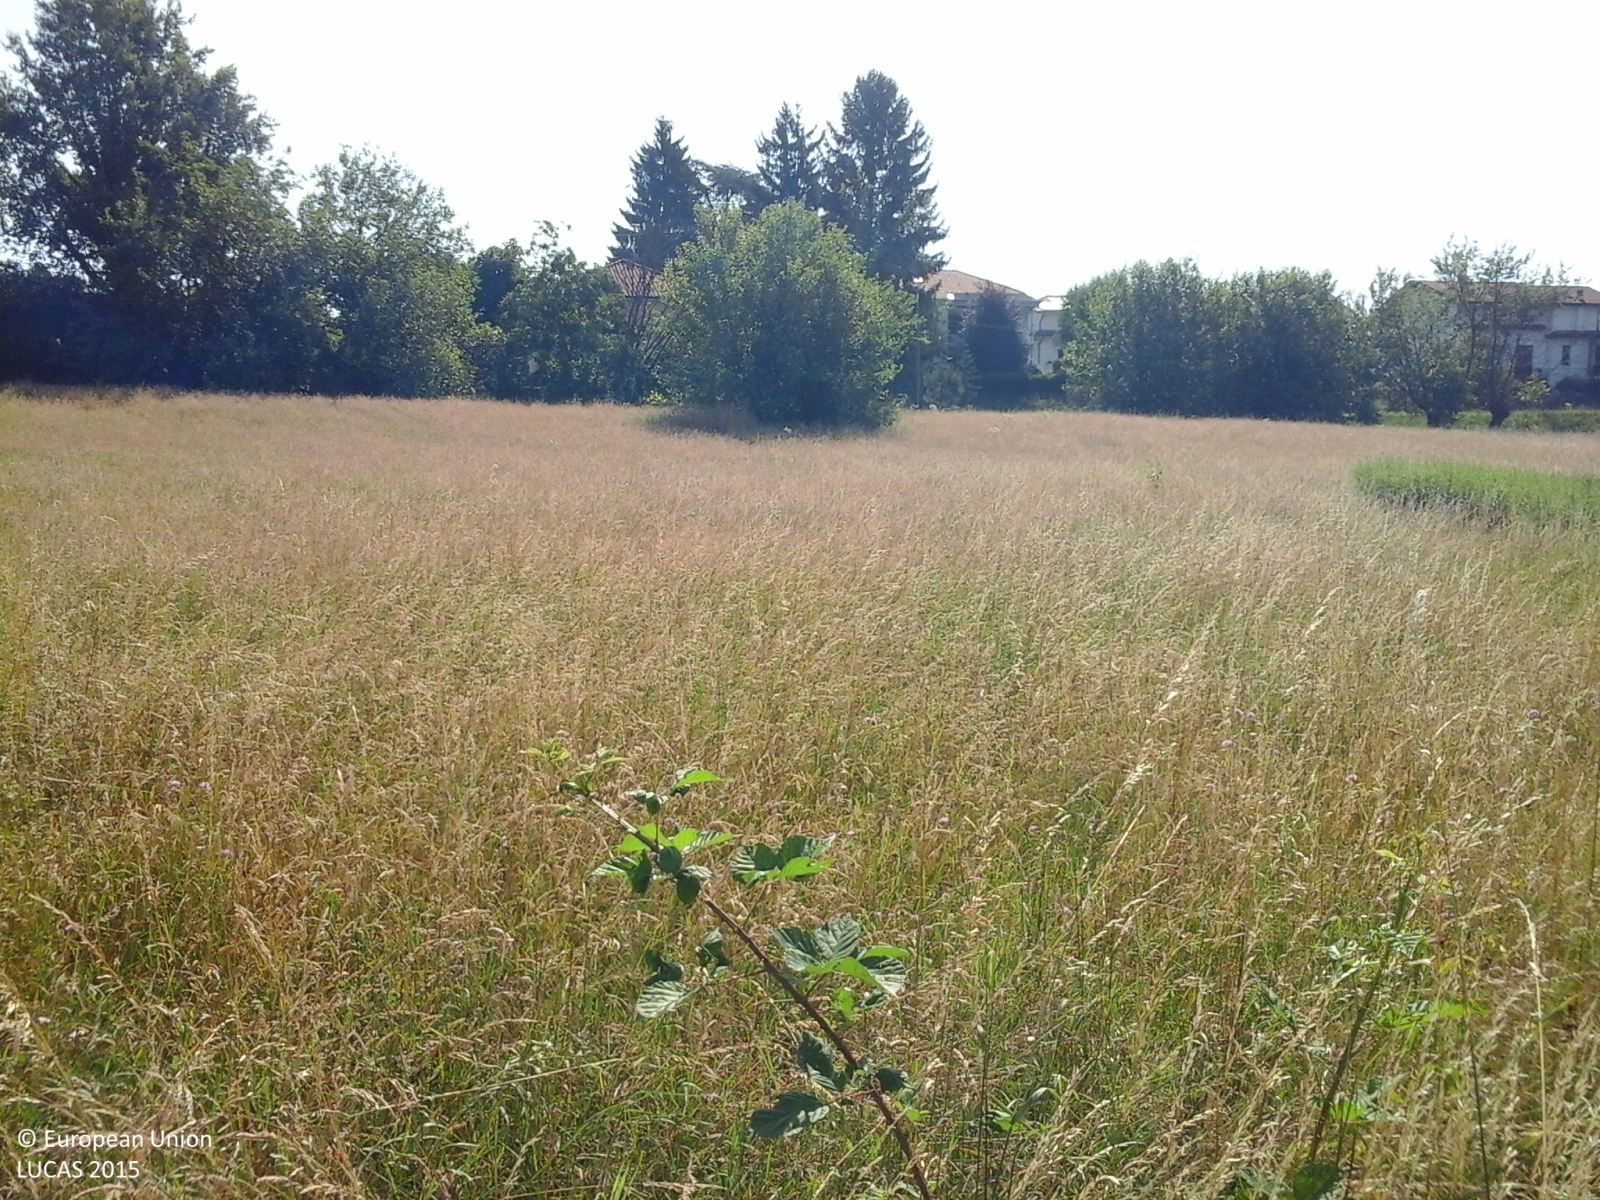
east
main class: Grassland
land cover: Grassland with sparse tree/shrub cover
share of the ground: > 75 %
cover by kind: herbaceous plants 95 %, broadleaved forest trees 5 %
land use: Residential
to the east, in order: Grassland with sparse tree/shrub cover; Managed hedges; Fences; Grassland without tree/shrub cover; Abandoned hedges; Artificial constructions in urban areas; Grassland without tree/shrub cover; Artificial constructions in urban areas
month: June
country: IT
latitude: 45.6776
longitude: 8.7823
